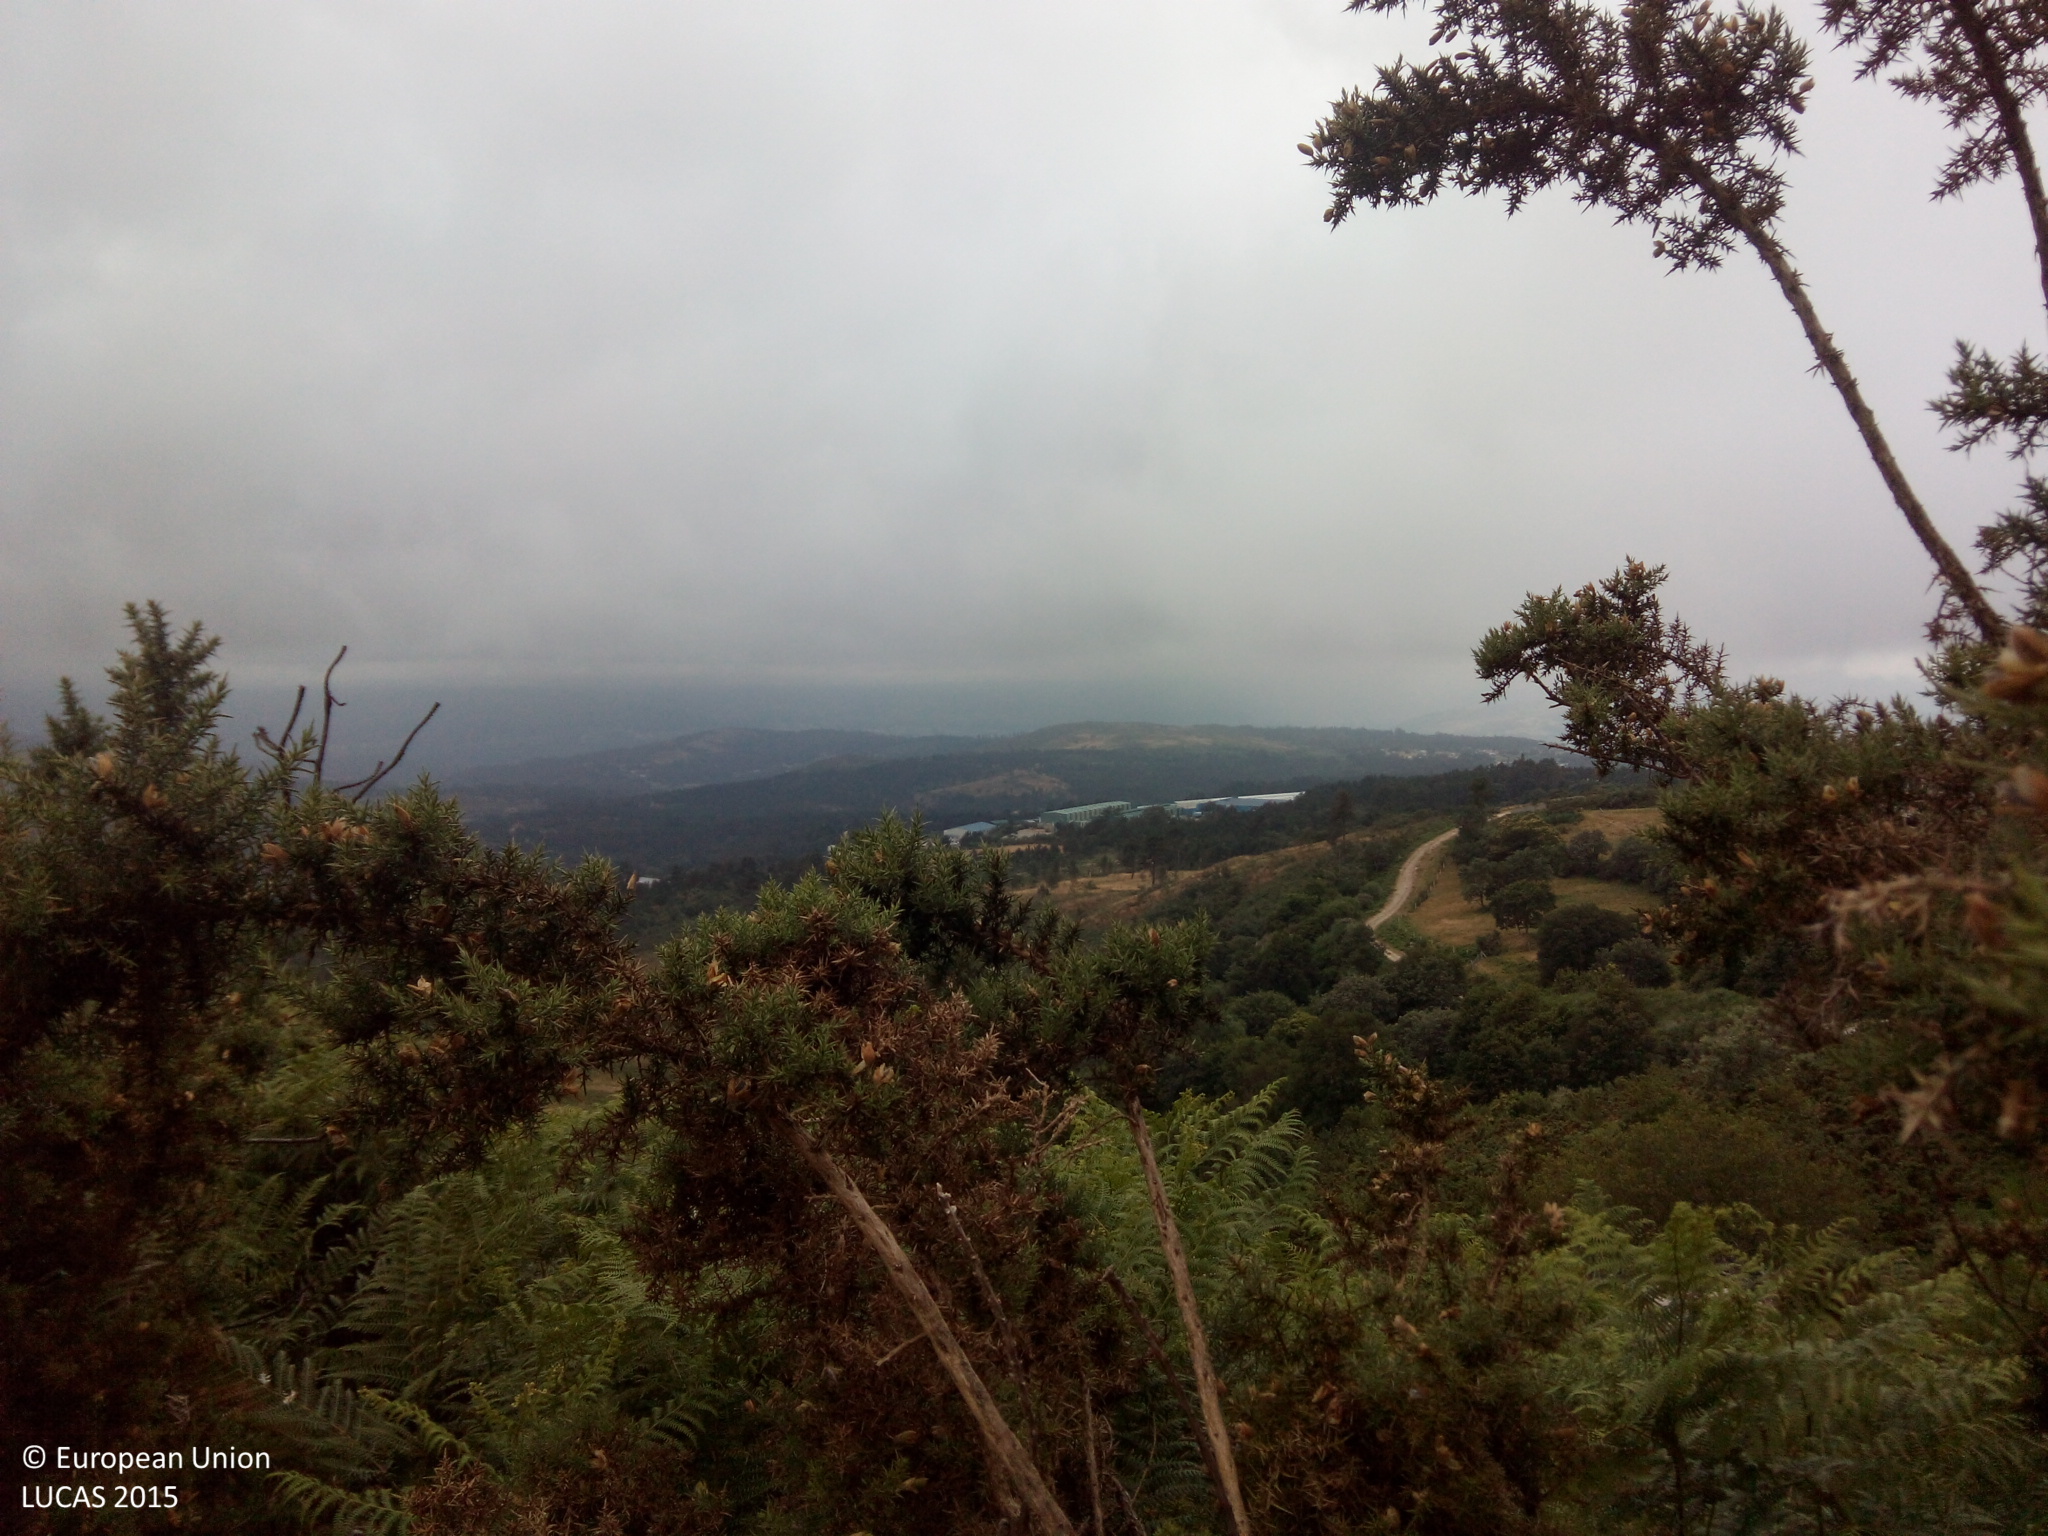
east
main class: Shrubland
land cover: Shrubland with sparse tree cover
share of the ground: > 75 %
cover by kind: shrubs 95 %, coniferous forest trees 5 %
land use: Semi-natural and natural areas not in use
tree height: < 5 m
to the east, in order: Shrubland with sparse tree cover; Rock outcrops; Shrubland with sparse tree cover; Tracks; Fences; Shrubland without tree cover; Fences; Shrubland without tree cover; Rock outcrops; Shrubland without tree cover
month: July
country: ES
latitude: 42.2349
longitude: -8.2510
